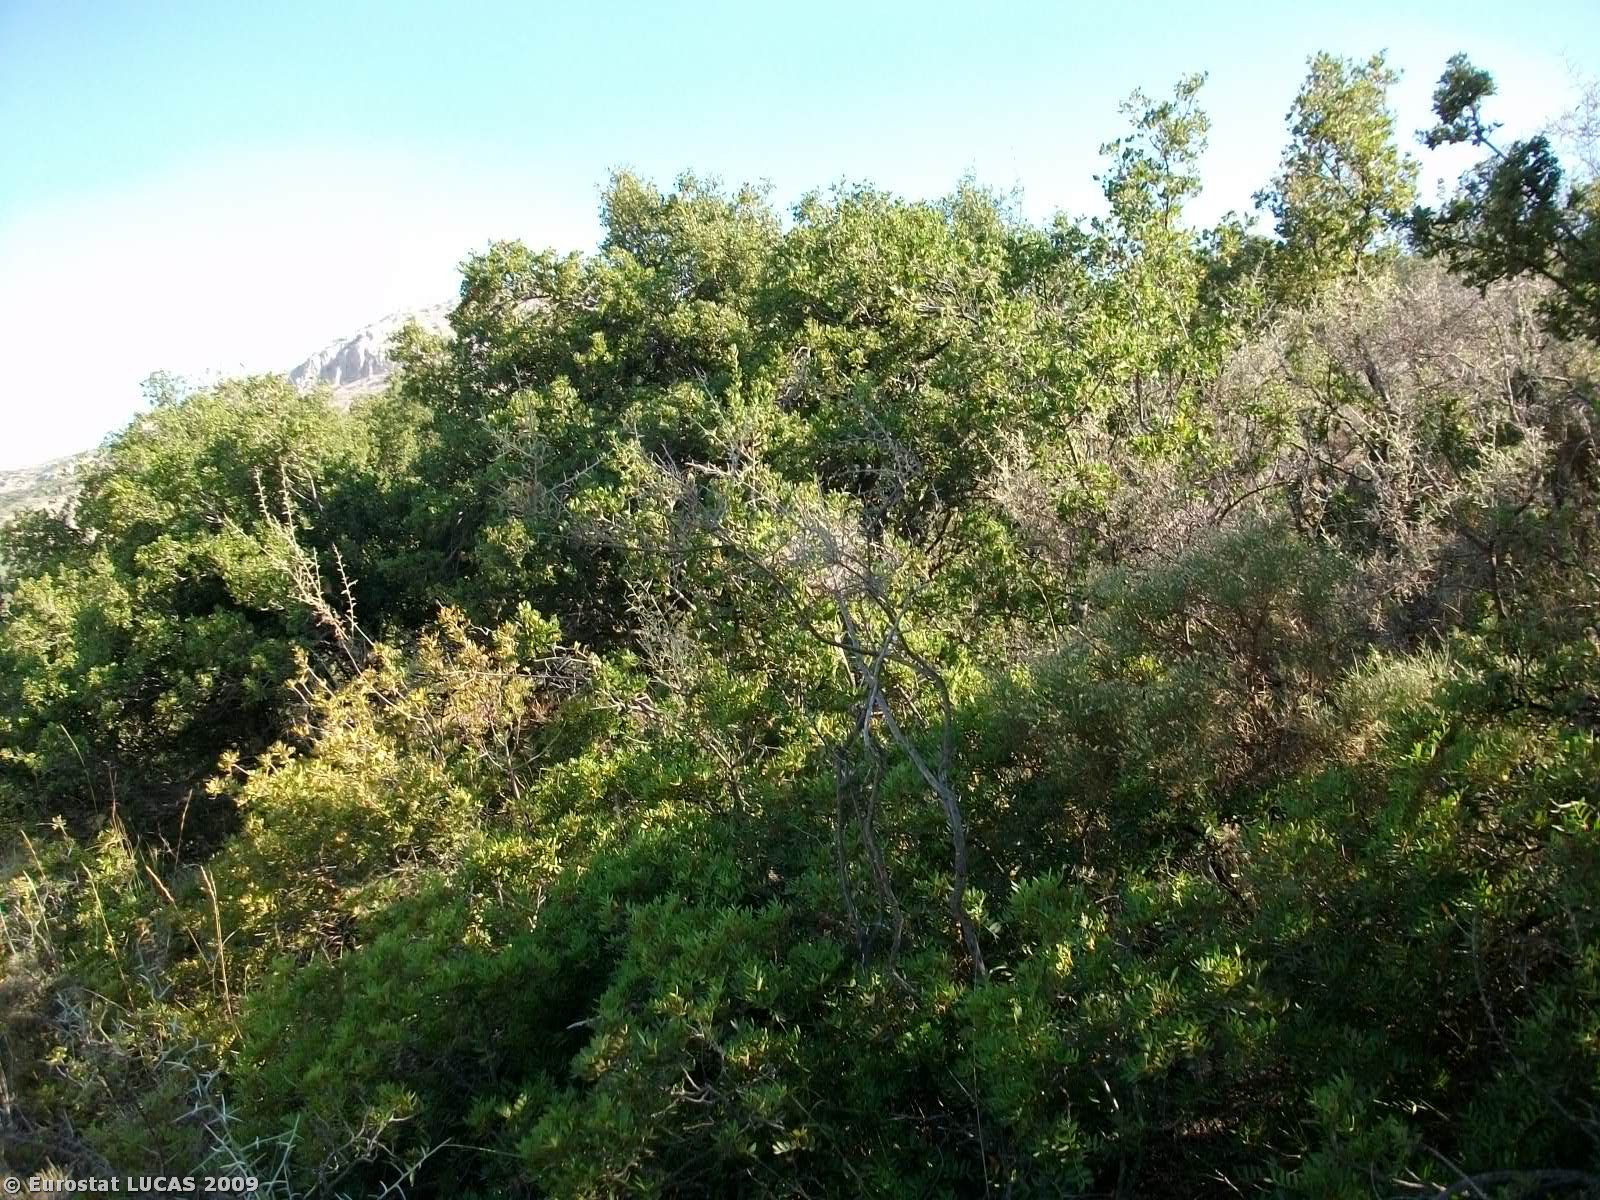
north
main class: Shrubland
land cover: Shrubland with sparse tree cover
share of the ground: > 75 %
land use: Unused
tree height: < 5 m
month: July
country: GR
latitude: 37.6294
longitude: 22.9419
